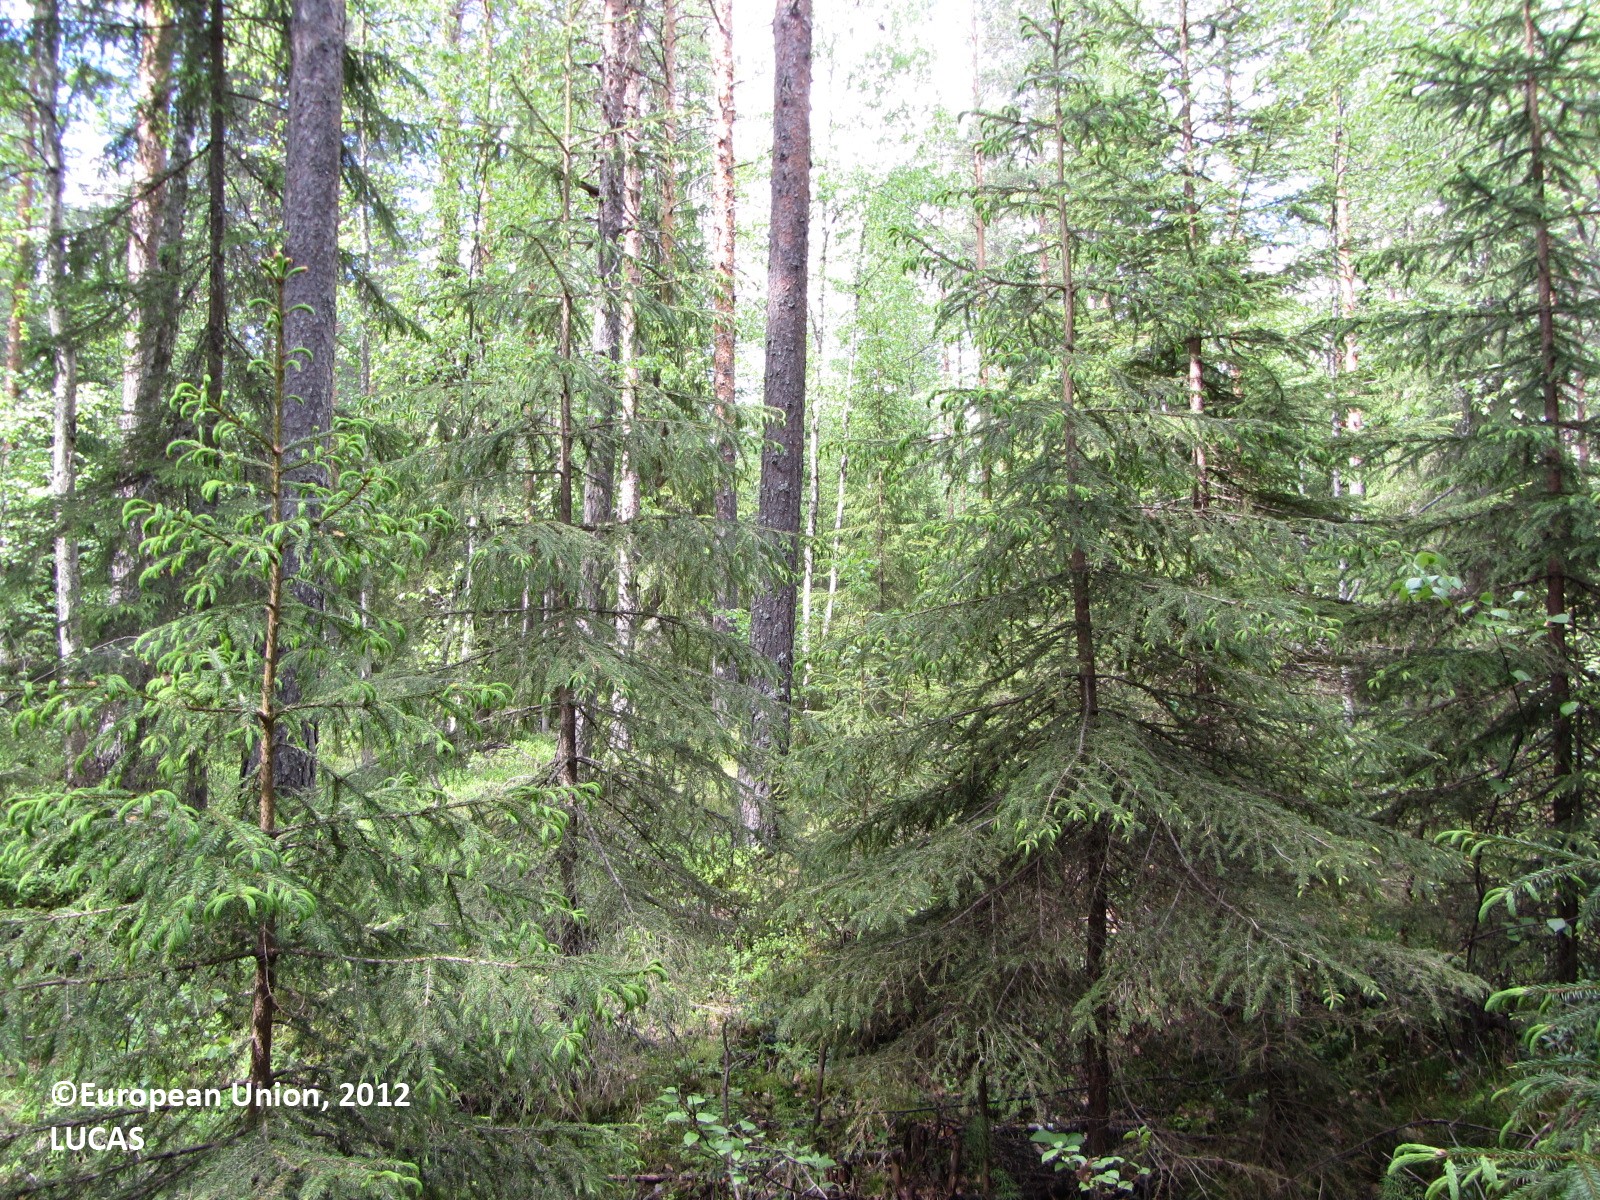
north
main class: Woodland
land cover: Other coniferous woodland
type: boreal forest
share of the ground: > 75 %
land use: Forestry
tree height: > 5 m
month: June
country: FI
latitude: 61.9300
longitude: 24.9834
